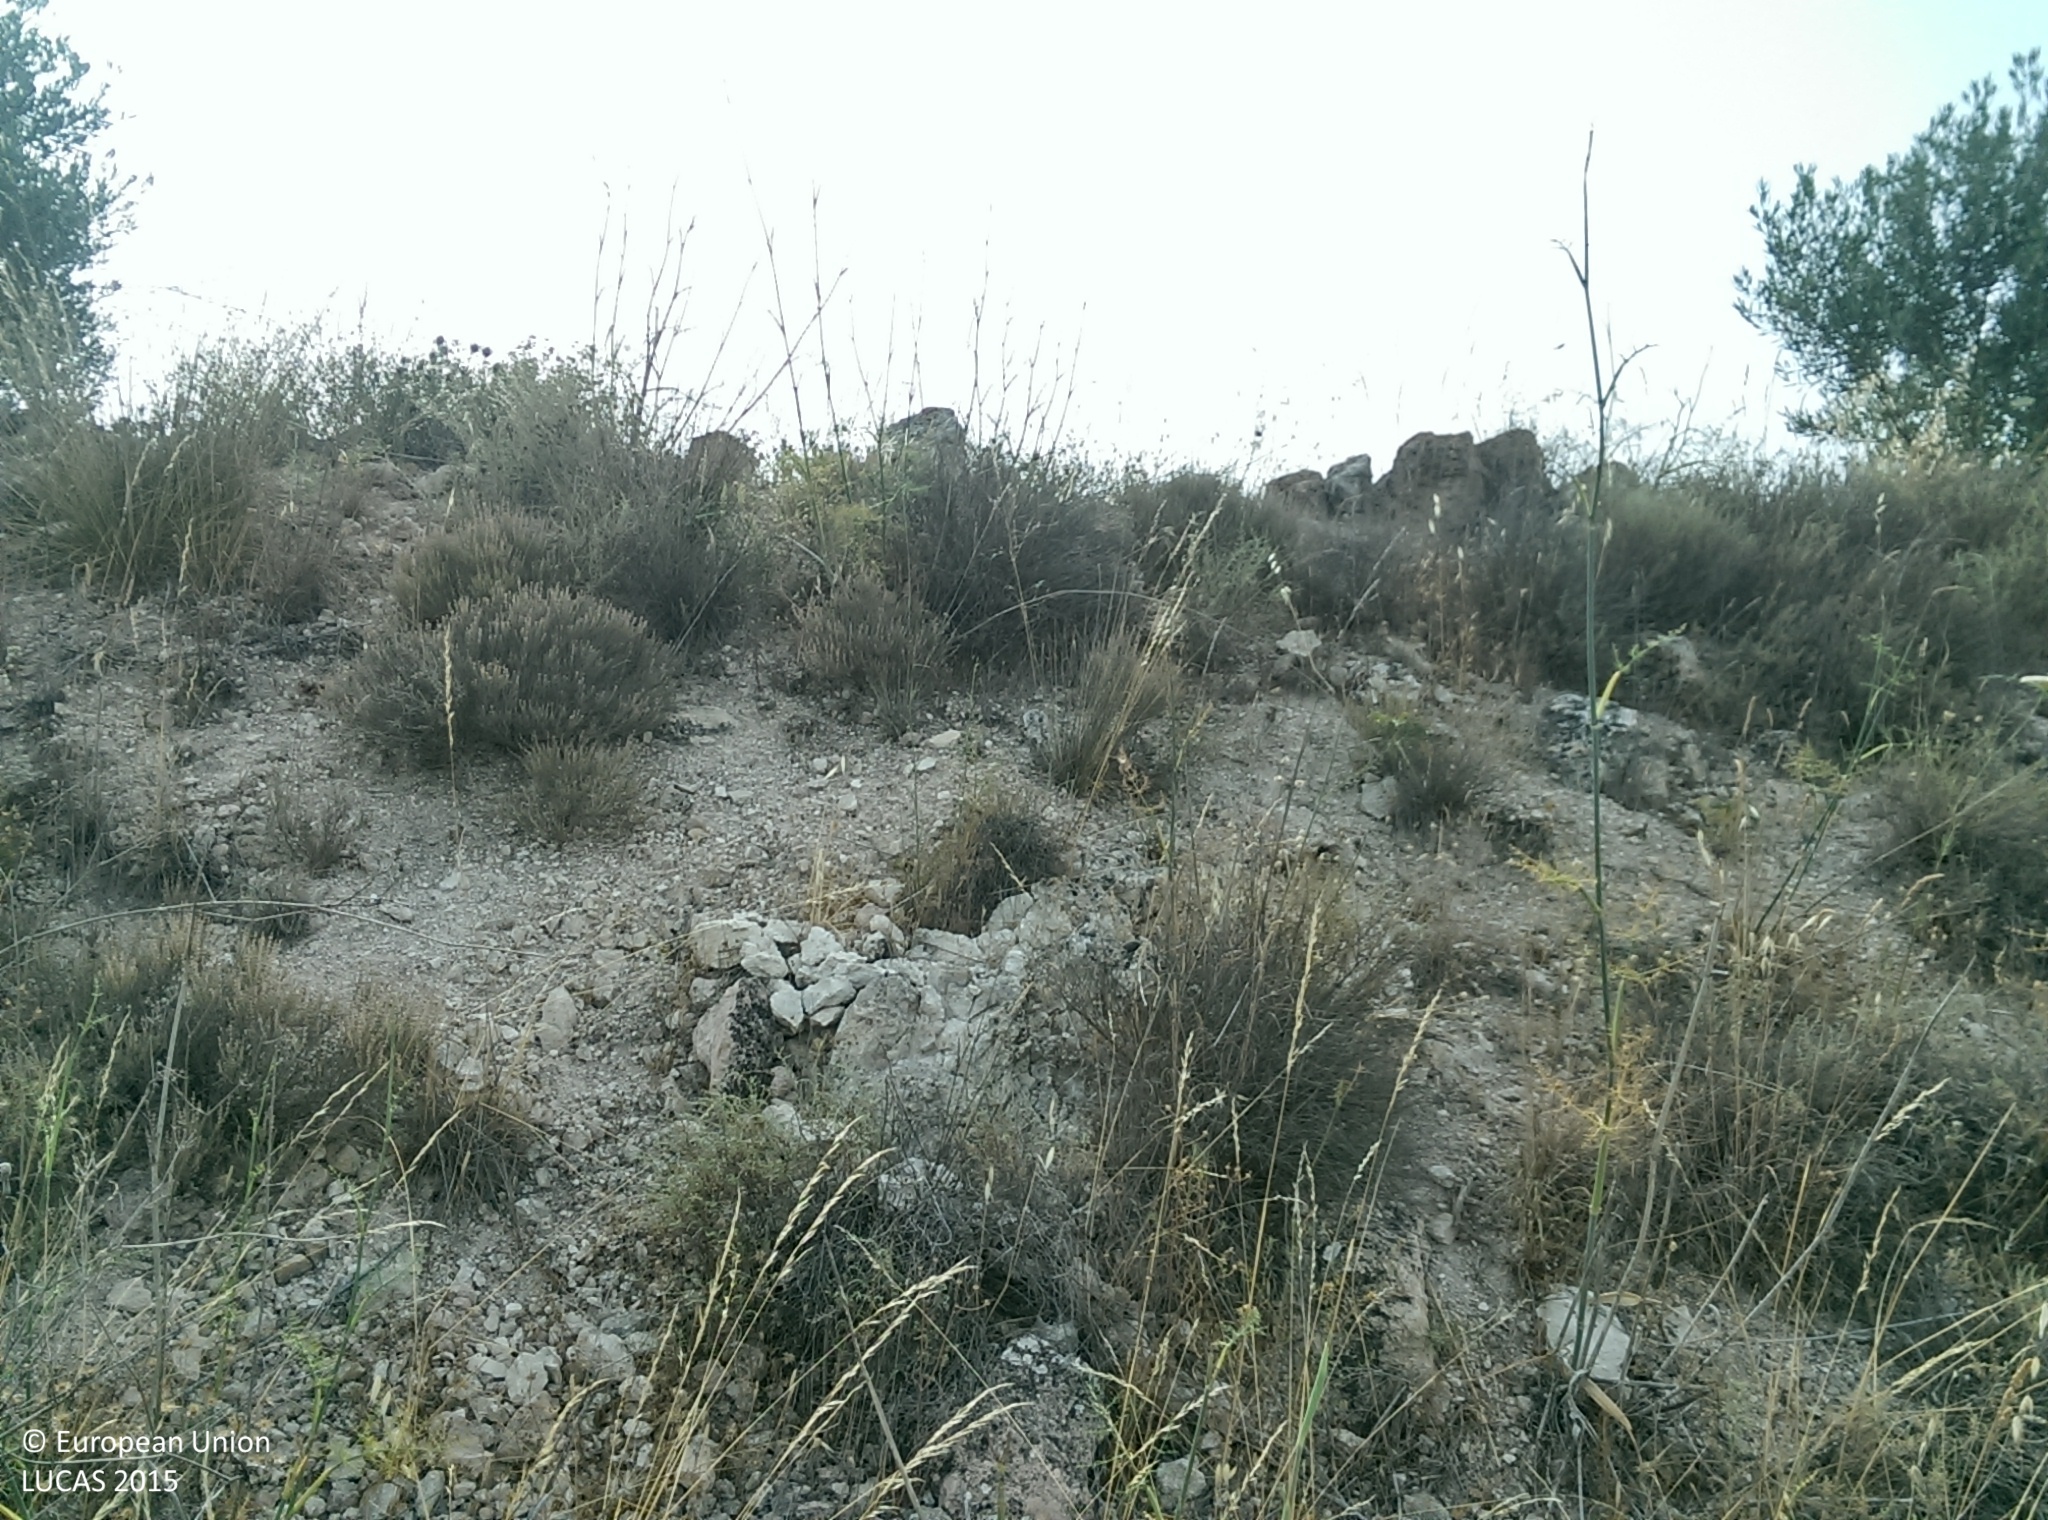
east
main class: Cropland
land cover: Olive groves
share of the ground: 10 - 25 %
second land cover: Spontaneously vegetated surfaces
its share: 50 - 75 %
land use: Agriculture (excluding fallow land and kitchen gardens)
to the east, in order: Olive groves; Spontaneously vegetated surfaces; Grass margins; Olive groves; Grass margins; Olive groves; Grass margins; Olive groves; Grass margins; Olive groves
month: July
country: ES
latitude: 37.5937
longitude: -2.9351
